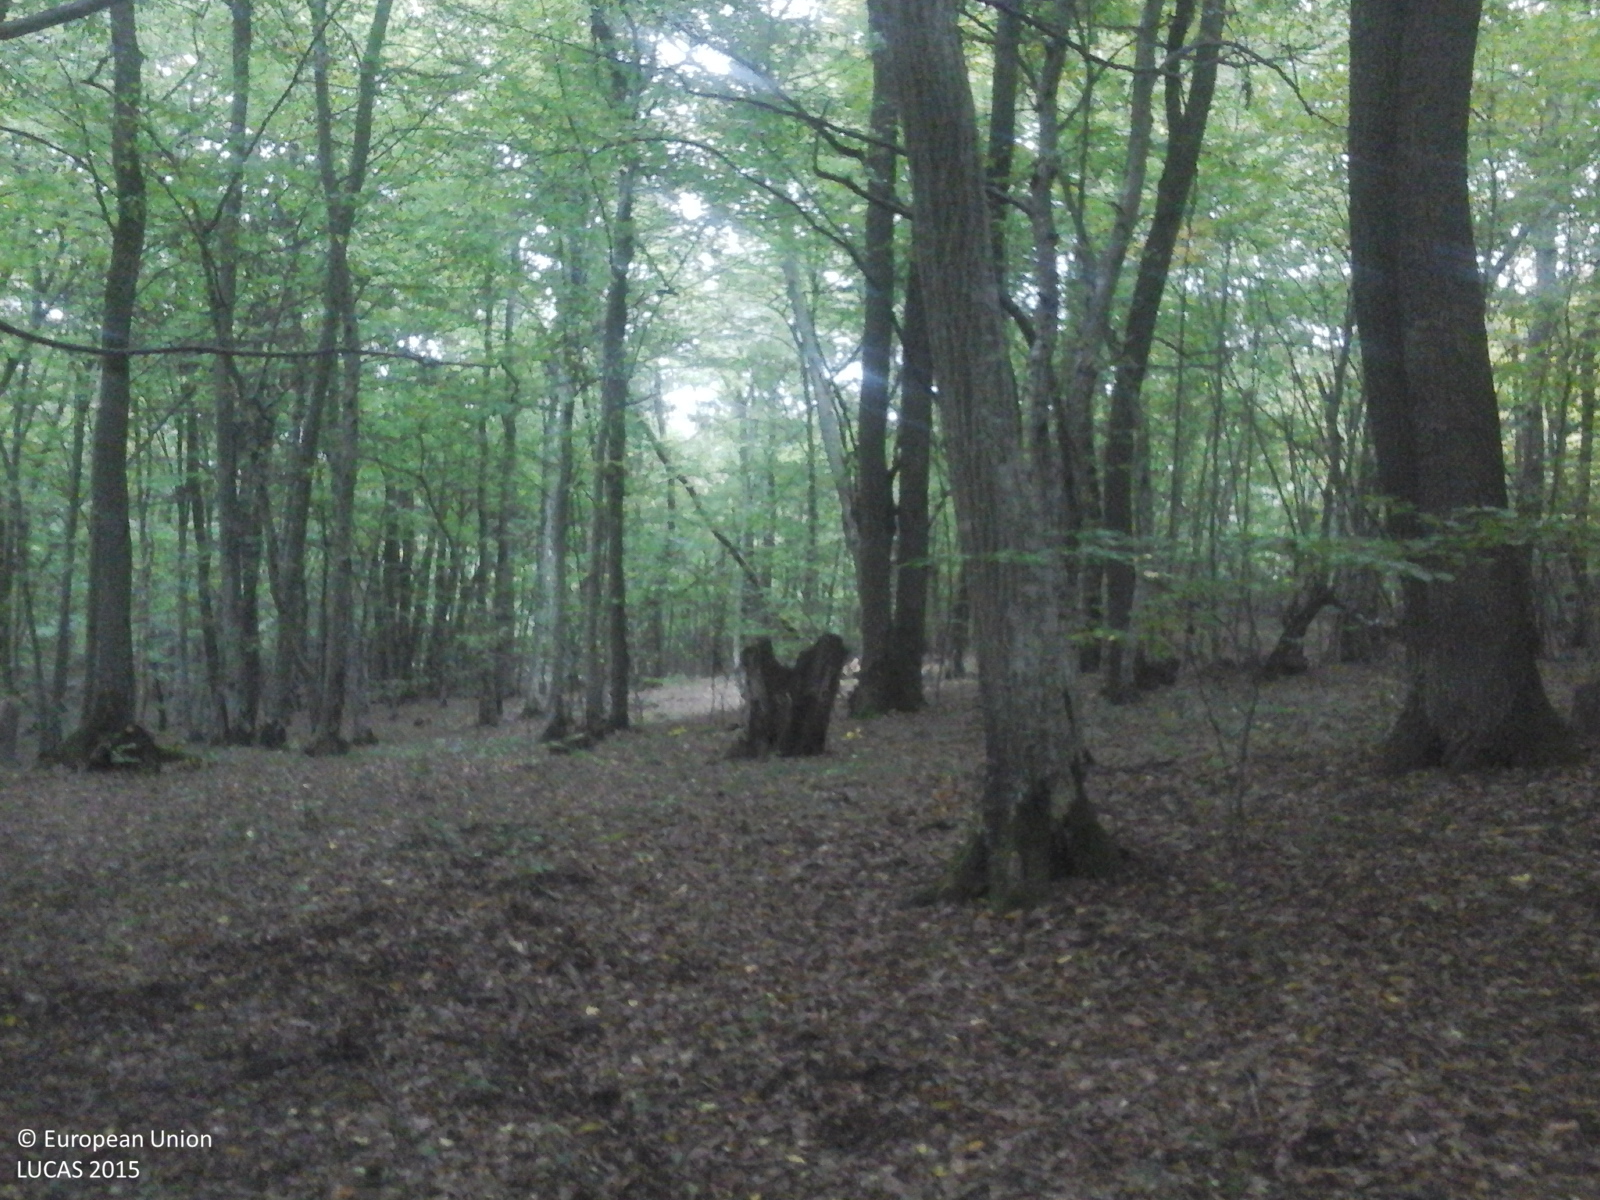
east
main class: Woodland
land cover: Broadleaved woodland
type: beech forest
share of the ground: > 75 %
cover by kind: broadleaved forest trees 100 %
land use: Forestry
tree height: > 5 m
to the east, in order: Broadleaved woodland; Tracks; Broadleaved woodland
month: October
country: RO
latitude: 45.9880
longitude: 25.0835
